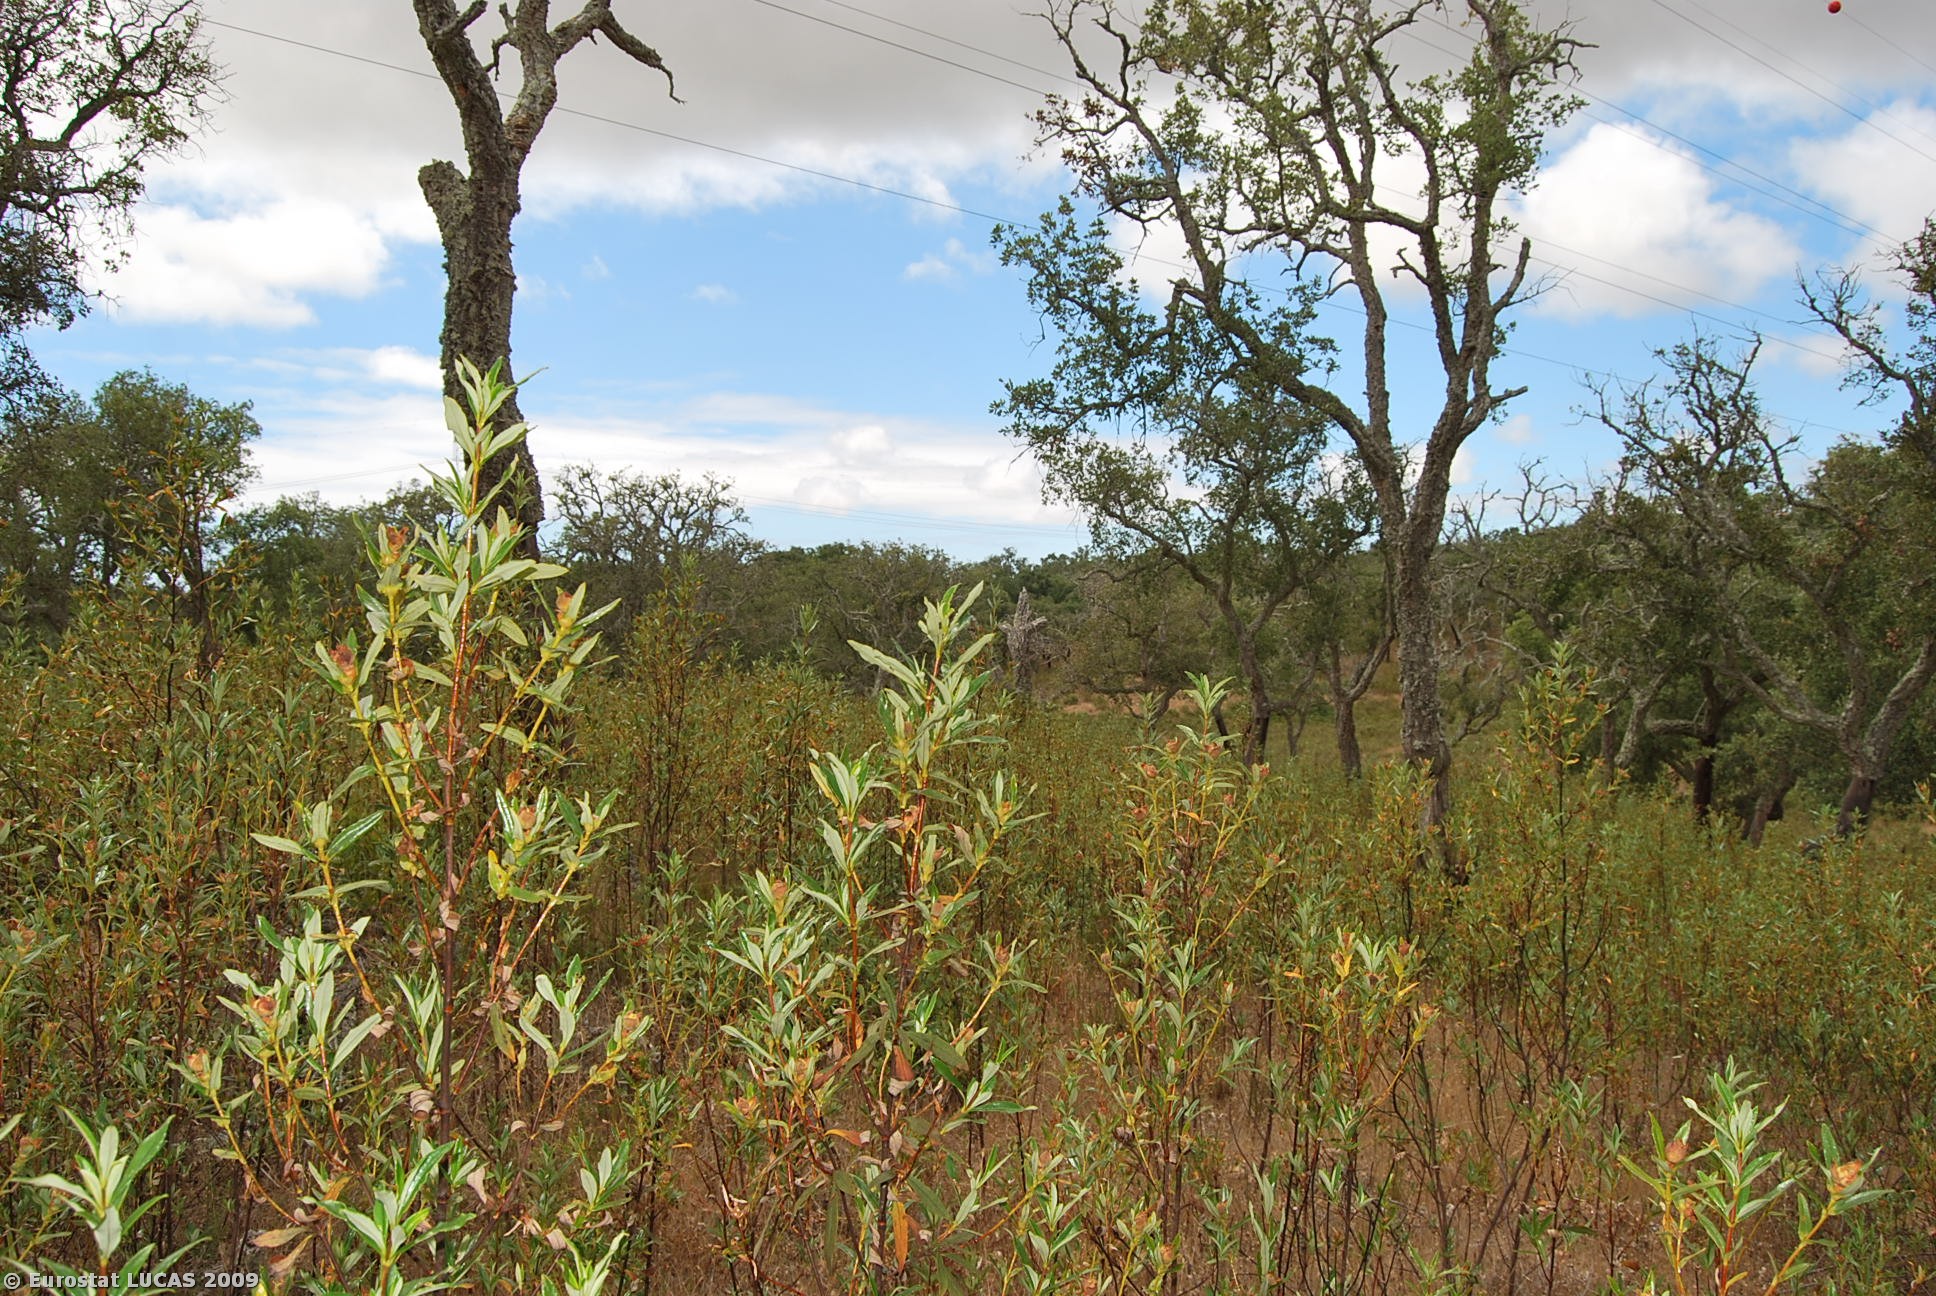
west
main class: Shrubland
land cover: Shrubland with sparse tree cover
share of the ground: > 75 %
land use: Unused
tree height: > 5 m
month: June
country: PT
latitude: 37.8985
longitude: -8.6848
